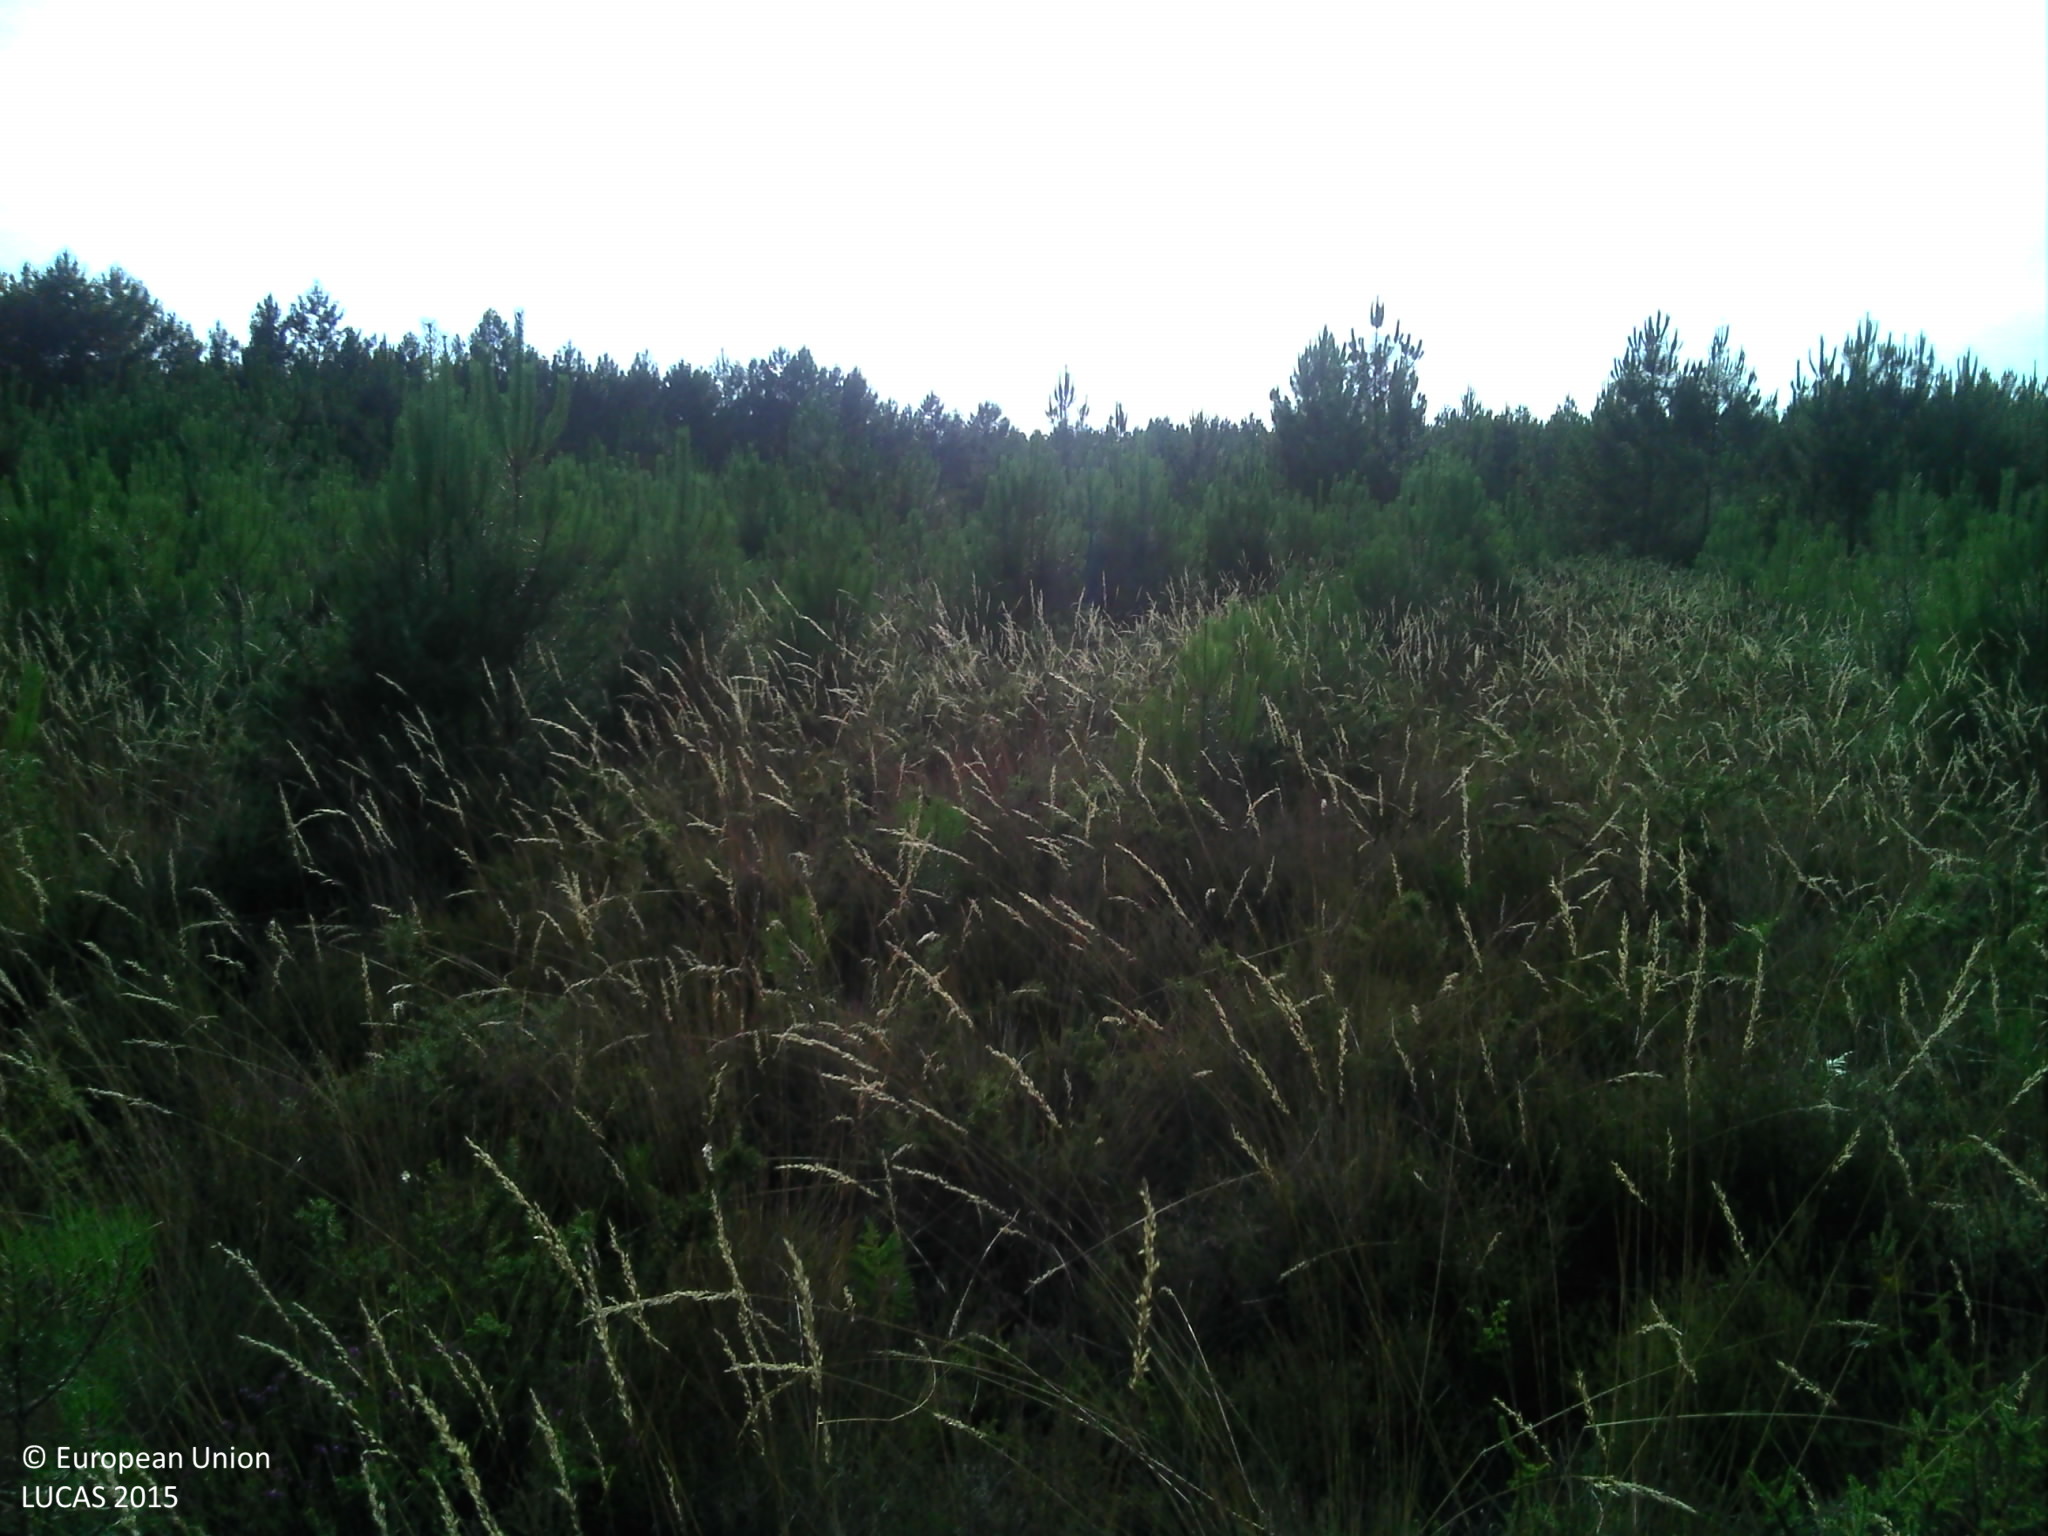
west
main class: Shrubland
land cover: Shrubland with sparse tree cover
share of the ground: > 75 %
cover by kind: shrubs 50 %, herbaceous plants 40 %, coniferous forest trees 5 %, lichens and mosses 5 %
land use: Forestry
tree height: < 5 m
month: July
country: FR
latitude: 43.7309
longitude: -1.3035
